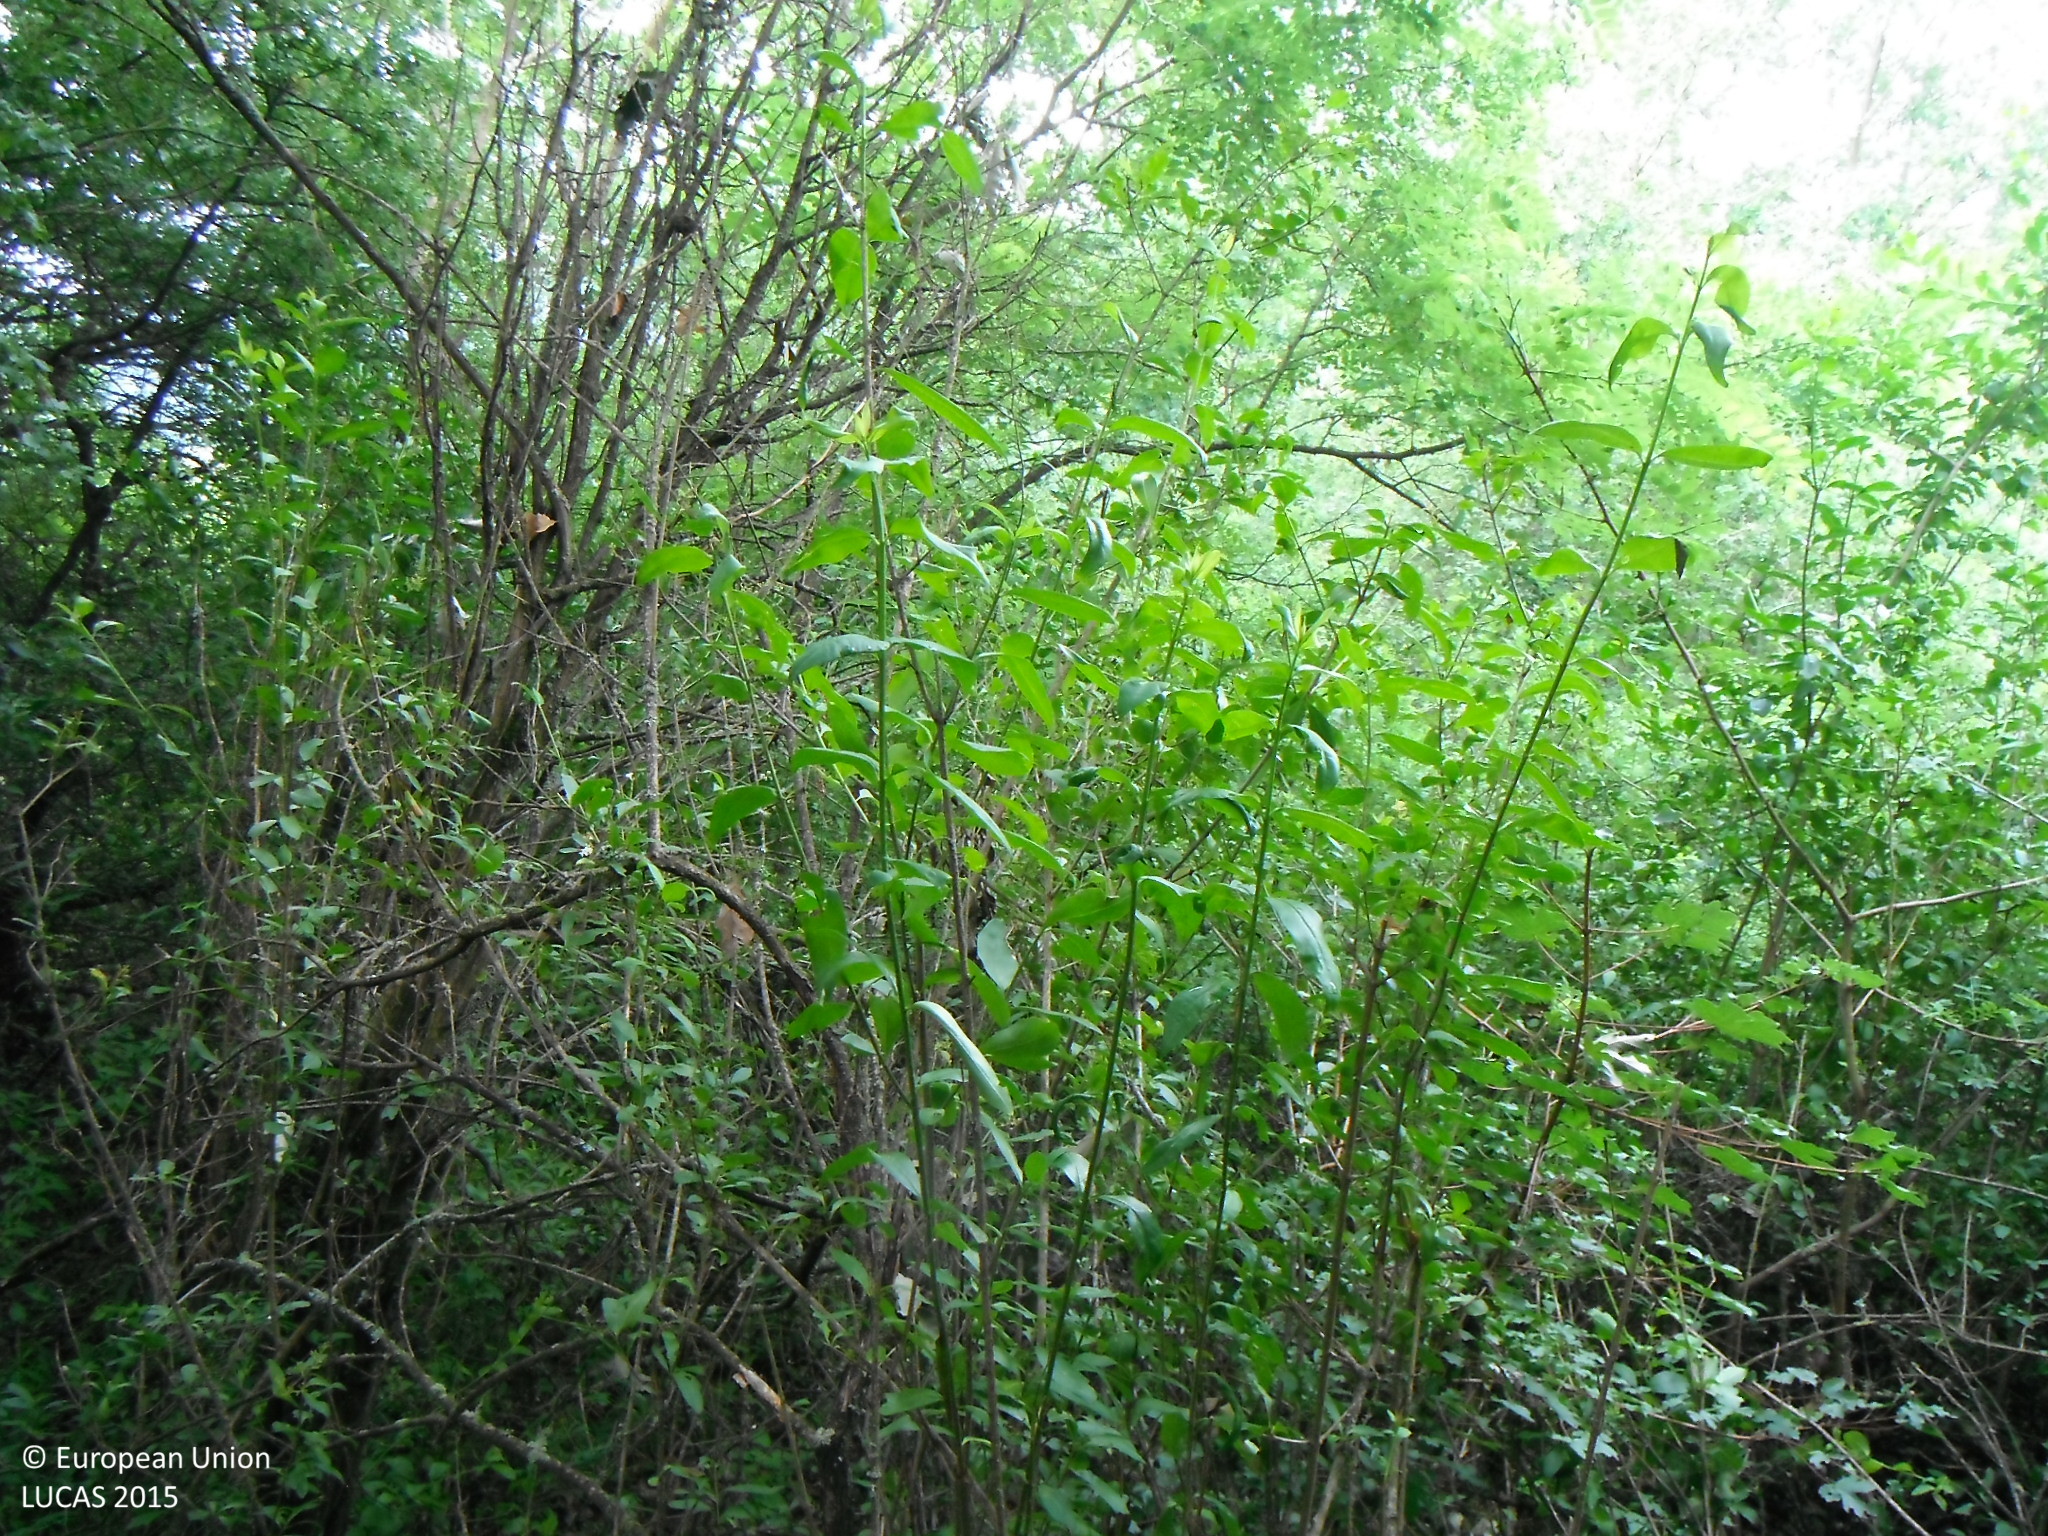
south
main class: Woodland
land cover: Broadleaved woodland
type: mesophytic deciduous forest
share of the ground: > 75 %
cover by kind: broadleaved forest trees 80 %, shrubs 10 %, herbaceous plants 10 %
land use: Forestry
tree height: > 5 m
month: June
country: SK
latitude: 48.2905
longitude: 19.4179
